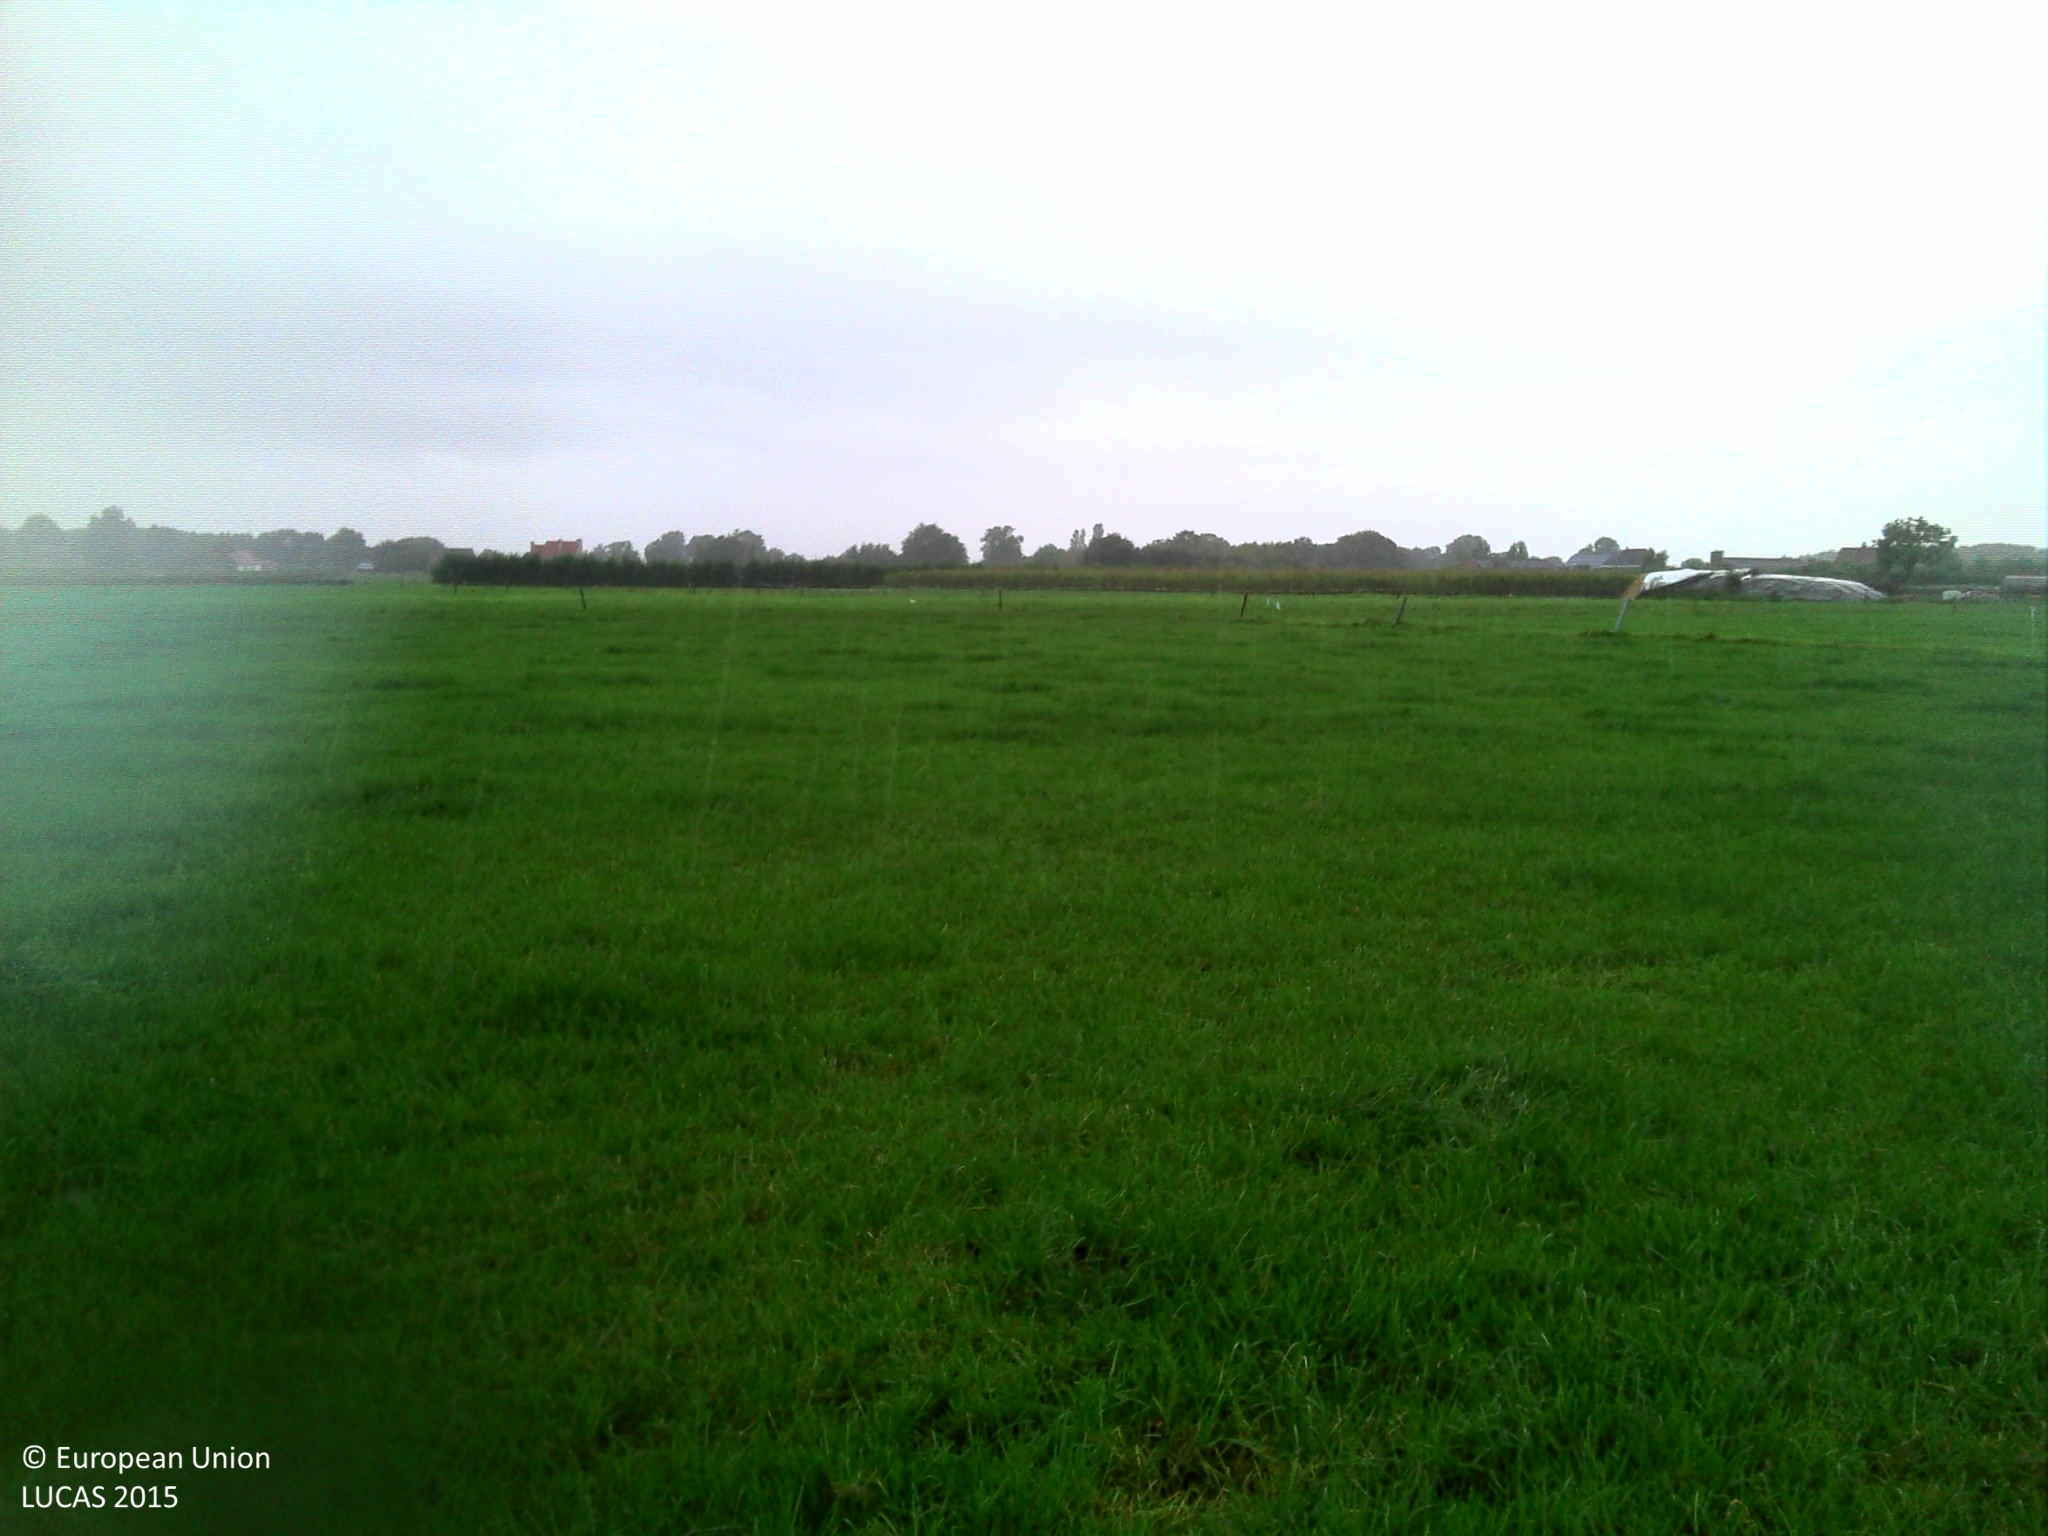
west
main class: Cropland
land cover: Temporary grasslands
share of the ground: > 75 %
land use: Agriculture (excluding fallow land and kitchen gardens)
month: September
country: BE
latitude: 51.3608
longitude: 4.7545
